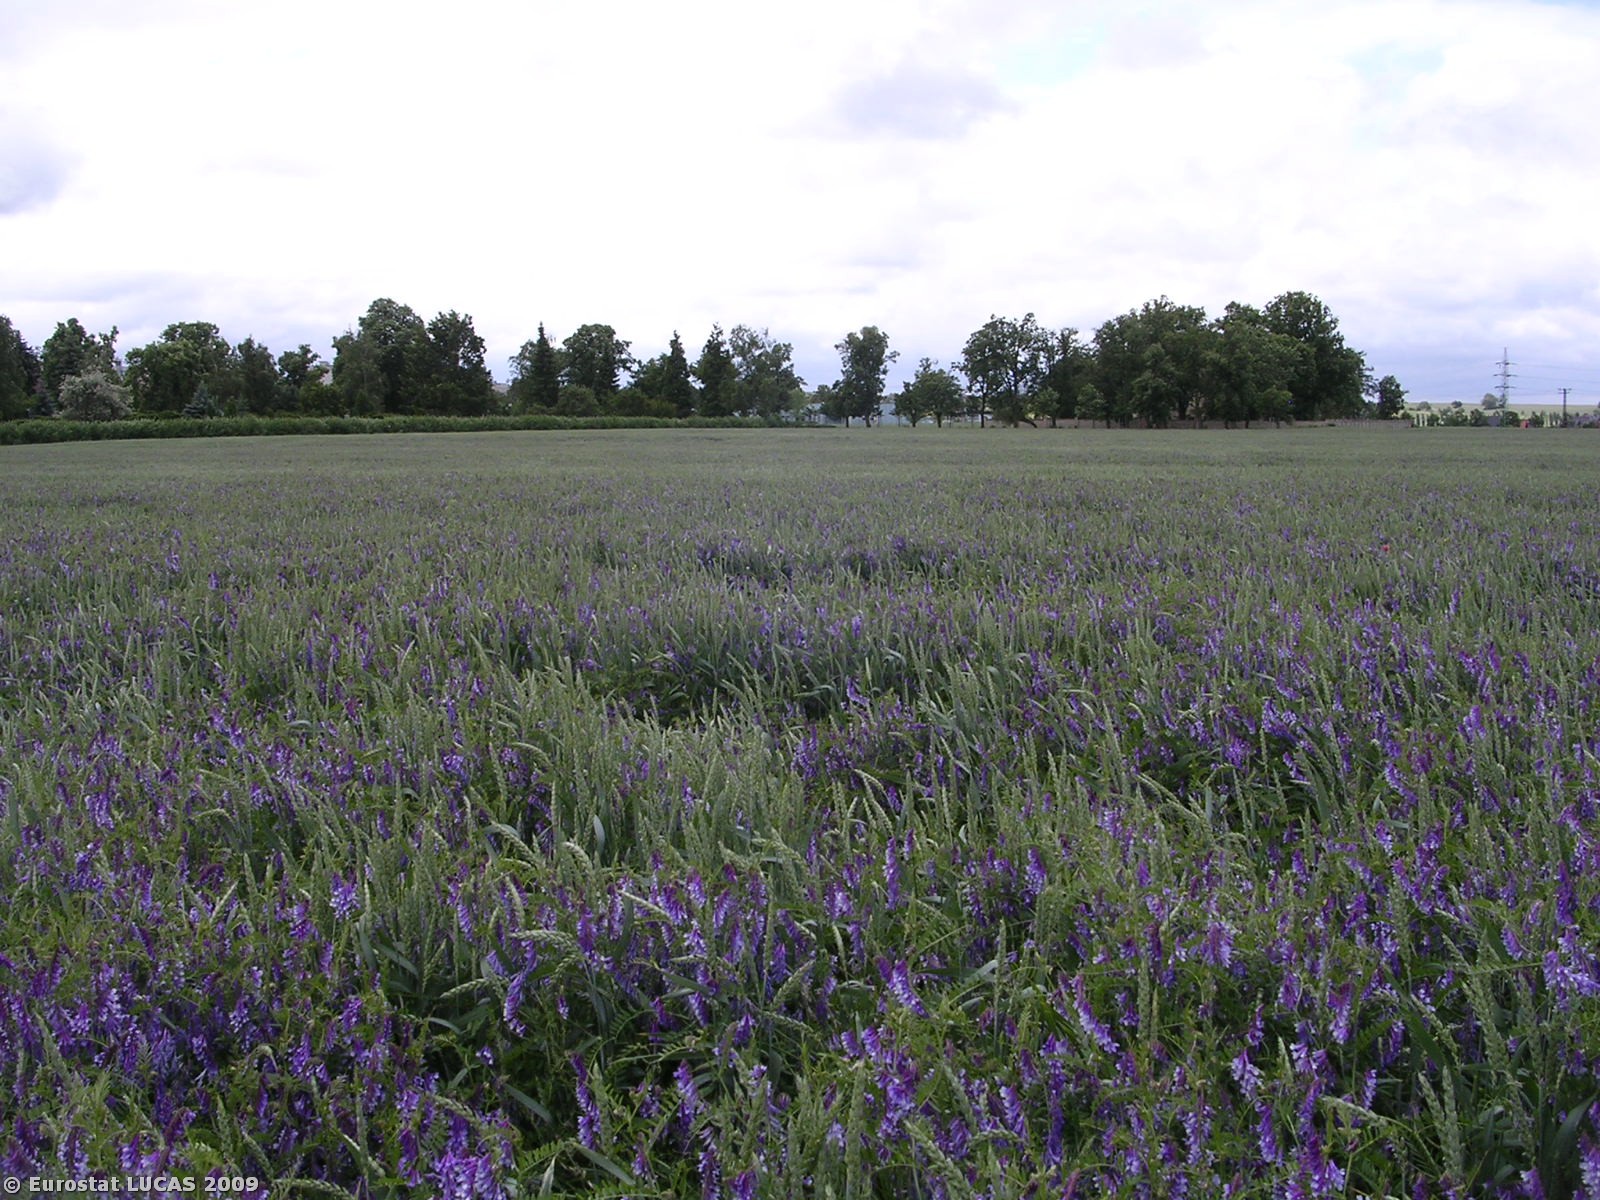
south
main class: Cropland
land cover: Common wheat
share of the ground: 50 - 75 %
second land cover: Dry pulses
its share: 25 - 50 %
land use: Agriculture (excluding fallow land and kitchen gardens)
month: May
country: CZ
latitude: 50.4296
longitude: 14.2386
